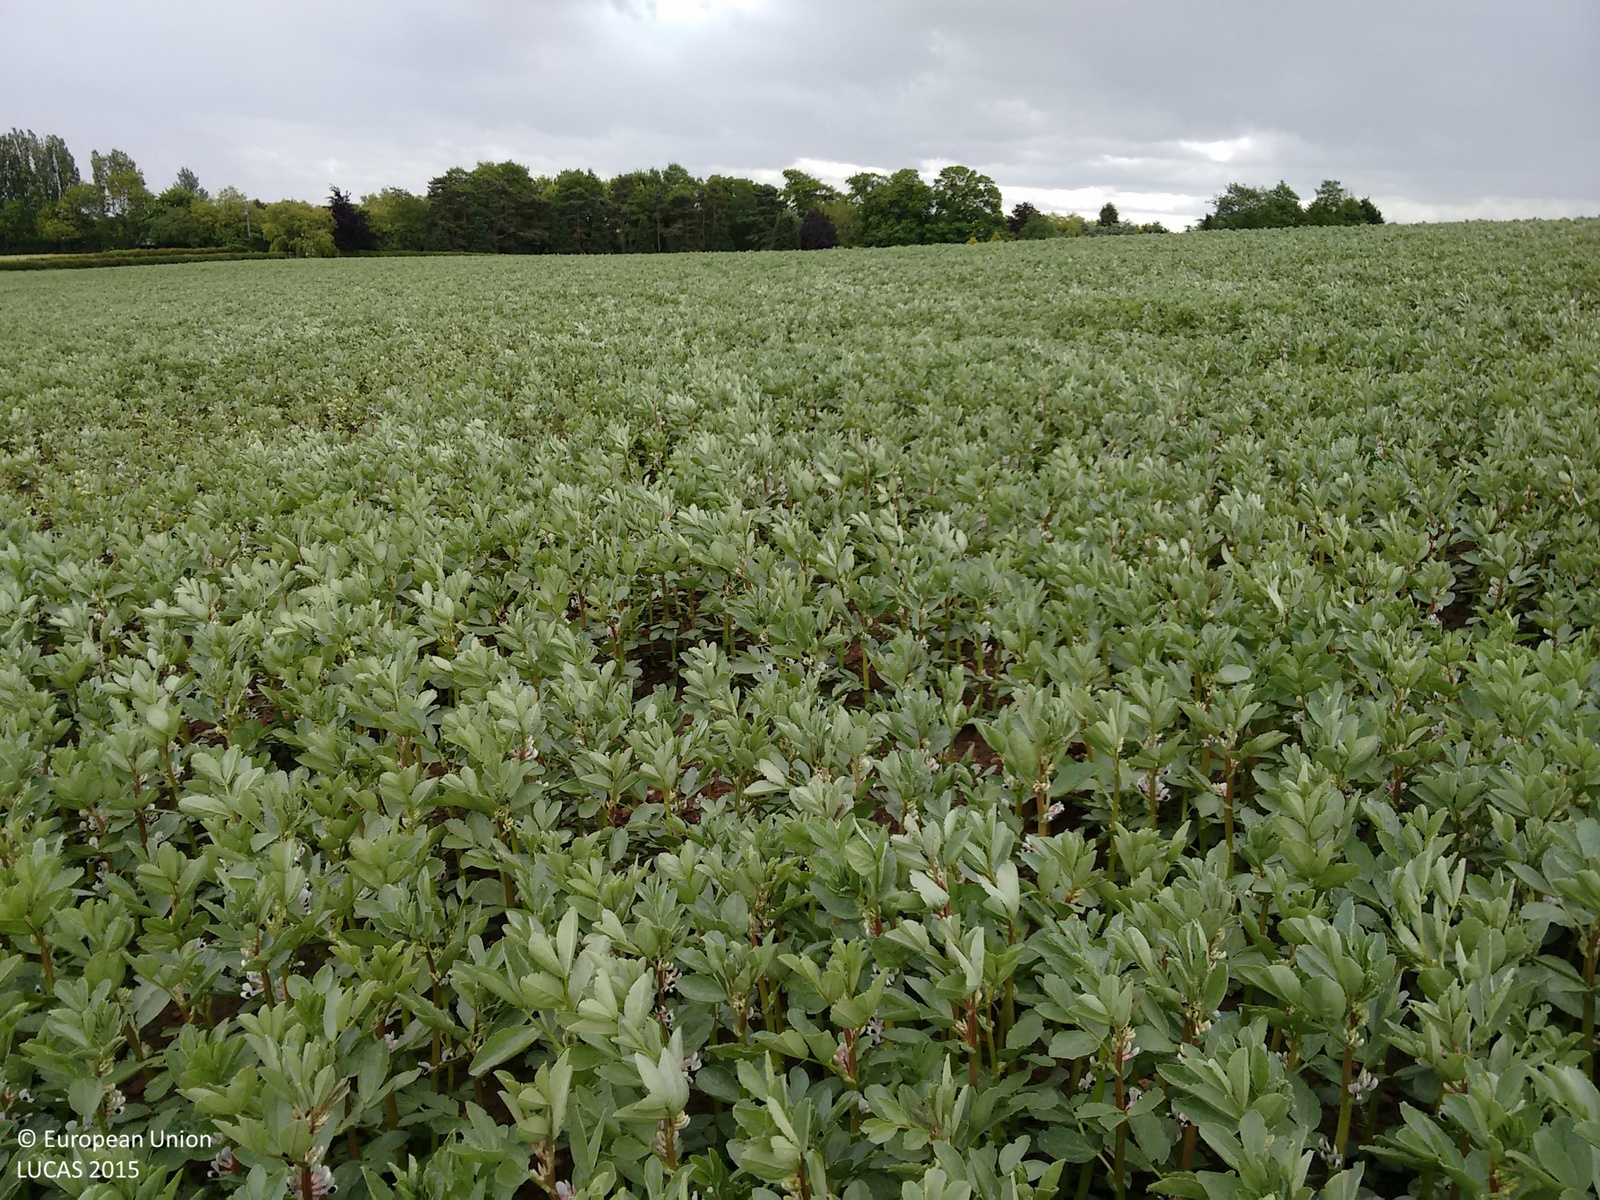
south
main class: Cropland
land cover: Dry pulses
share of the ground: > 75 %
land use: Agriculture (excluding fallow land and kitchen gardens)
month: June
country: GB
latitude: 54.0811
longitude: -1.3740
